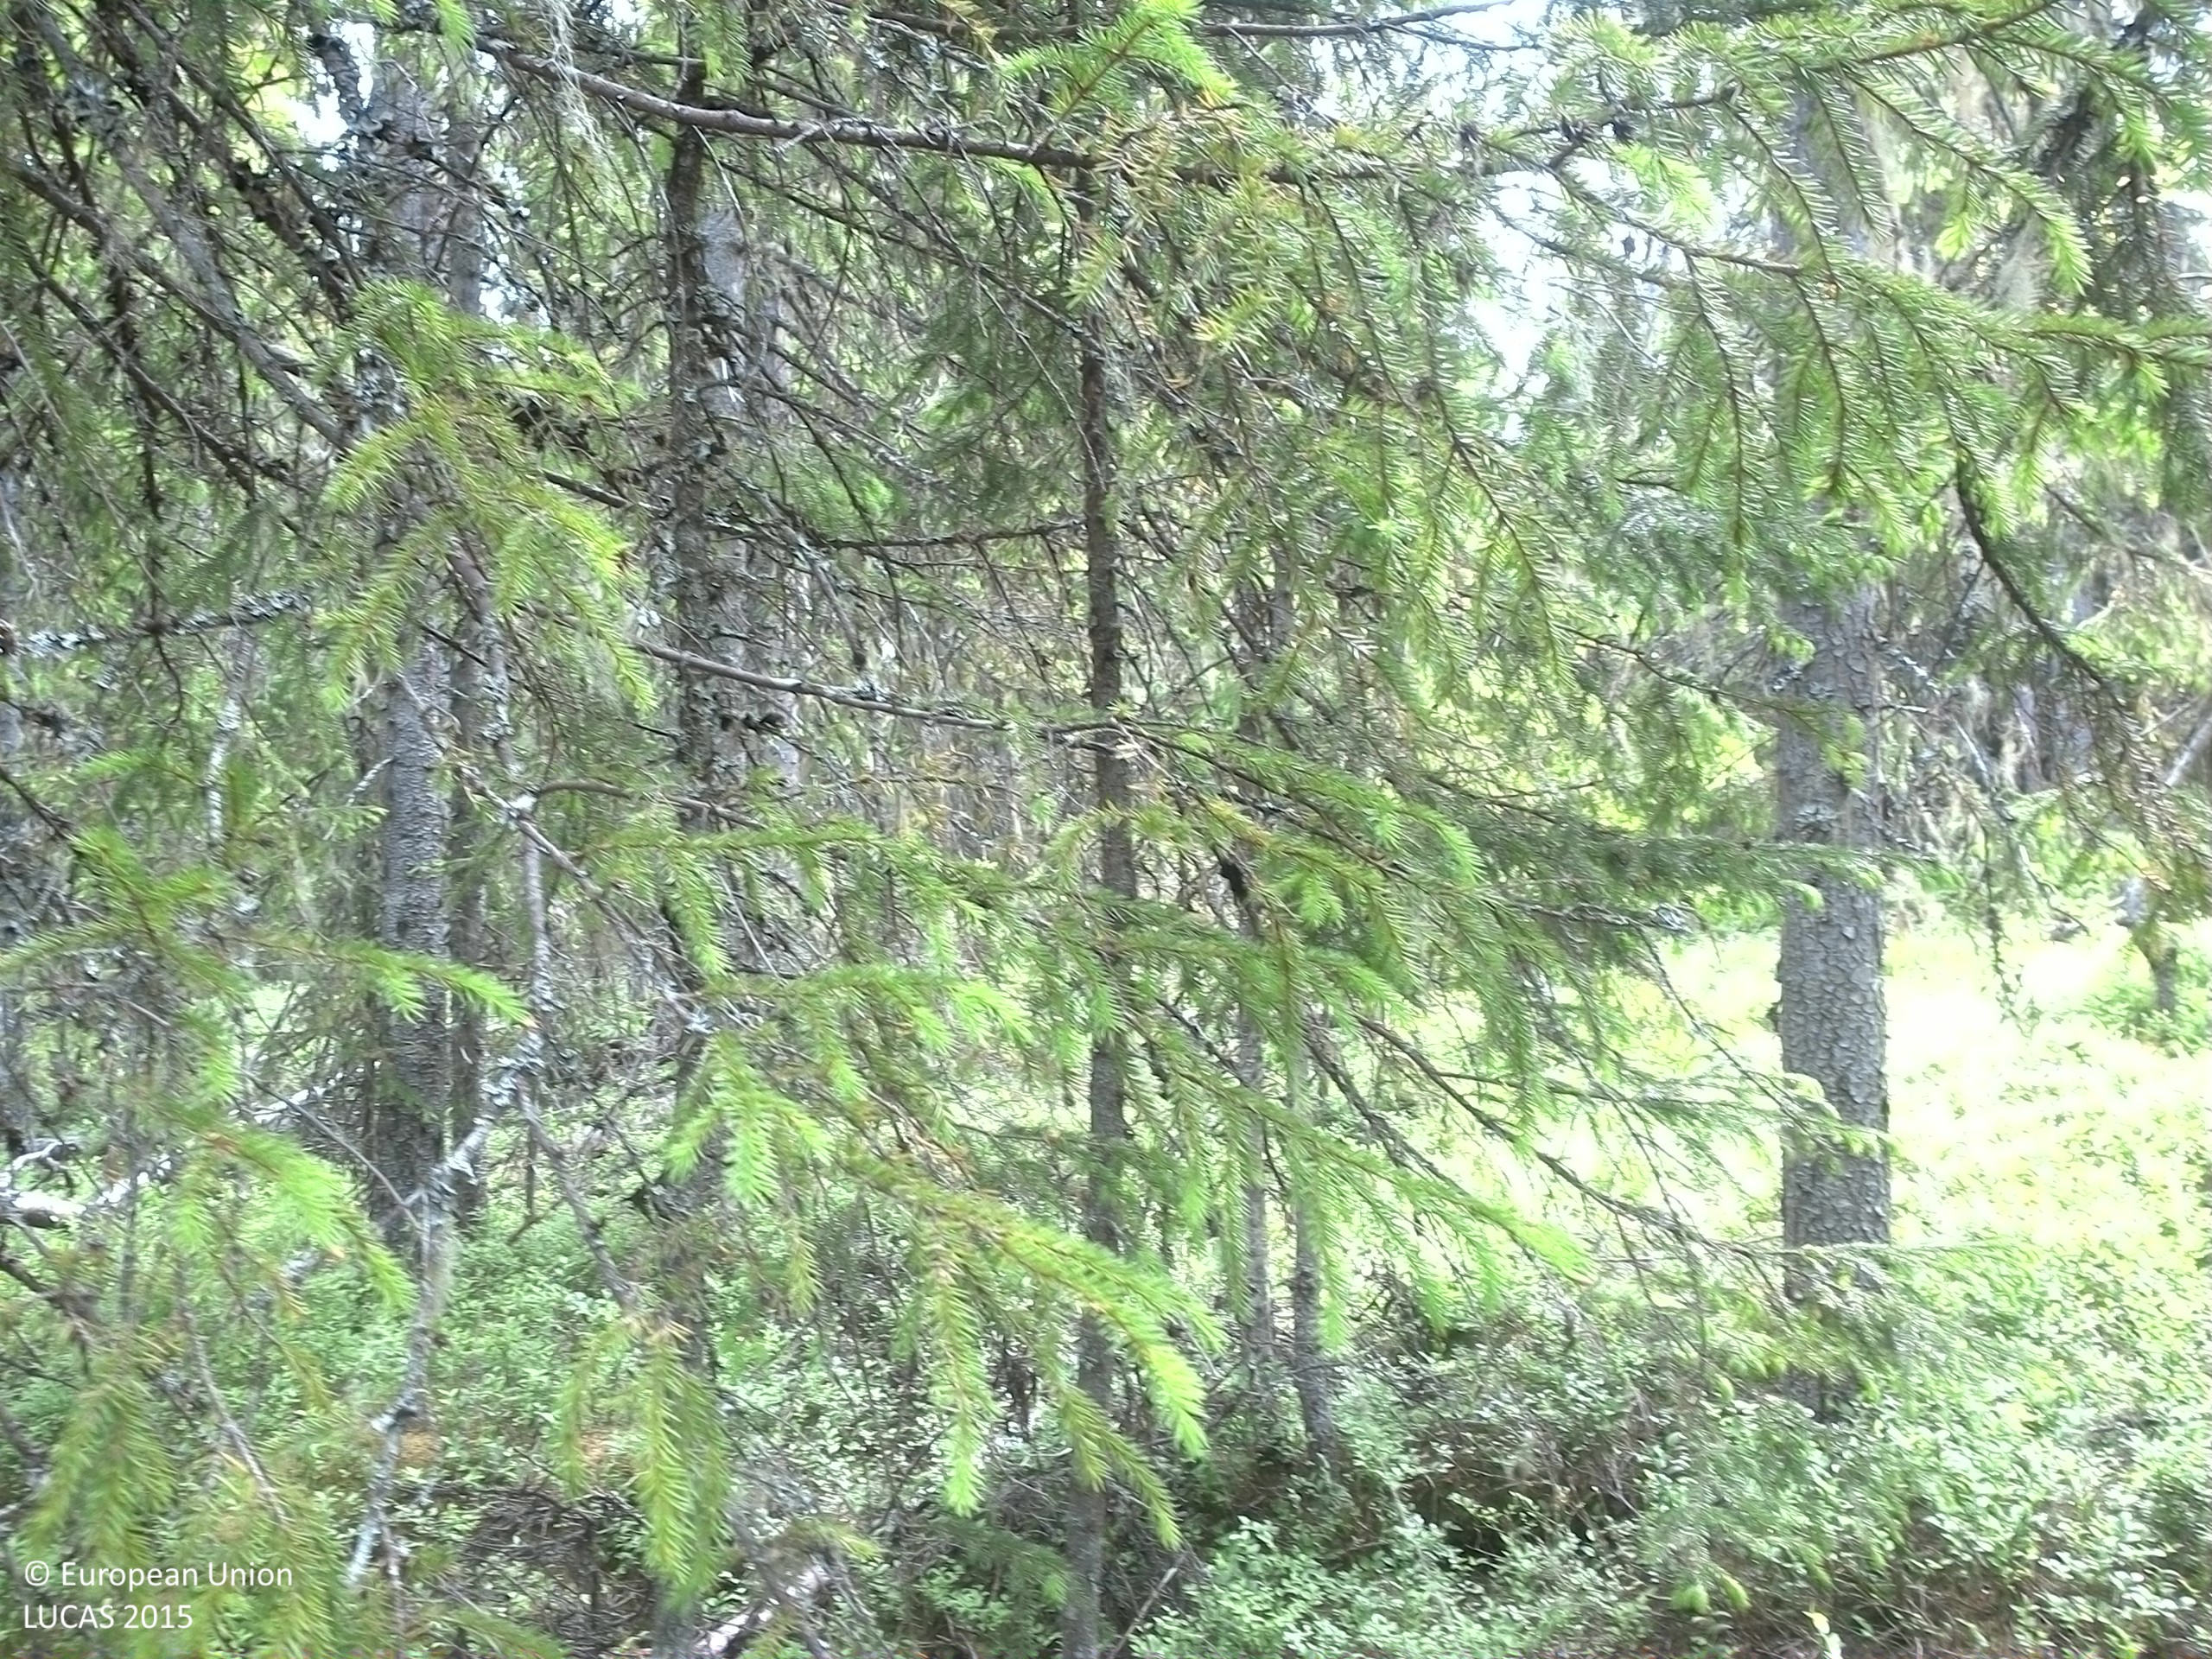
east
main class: Woodland
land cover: Spruce dominated coniferous woodland
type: boreal forest
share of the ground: 50 - 75 %
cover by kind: coniferous forest trees 60 %, shrubs 30 %, broadleaved forest trees 10 %
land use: Forestry
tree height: > 5 m
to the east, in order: Spruce dominated coniferous woodland; Rivers and streams; Spruce dominated coniferous woodland; Spruce dominated mixed woodland
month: June
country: SE
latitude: 62.8544
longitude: 17.6205
